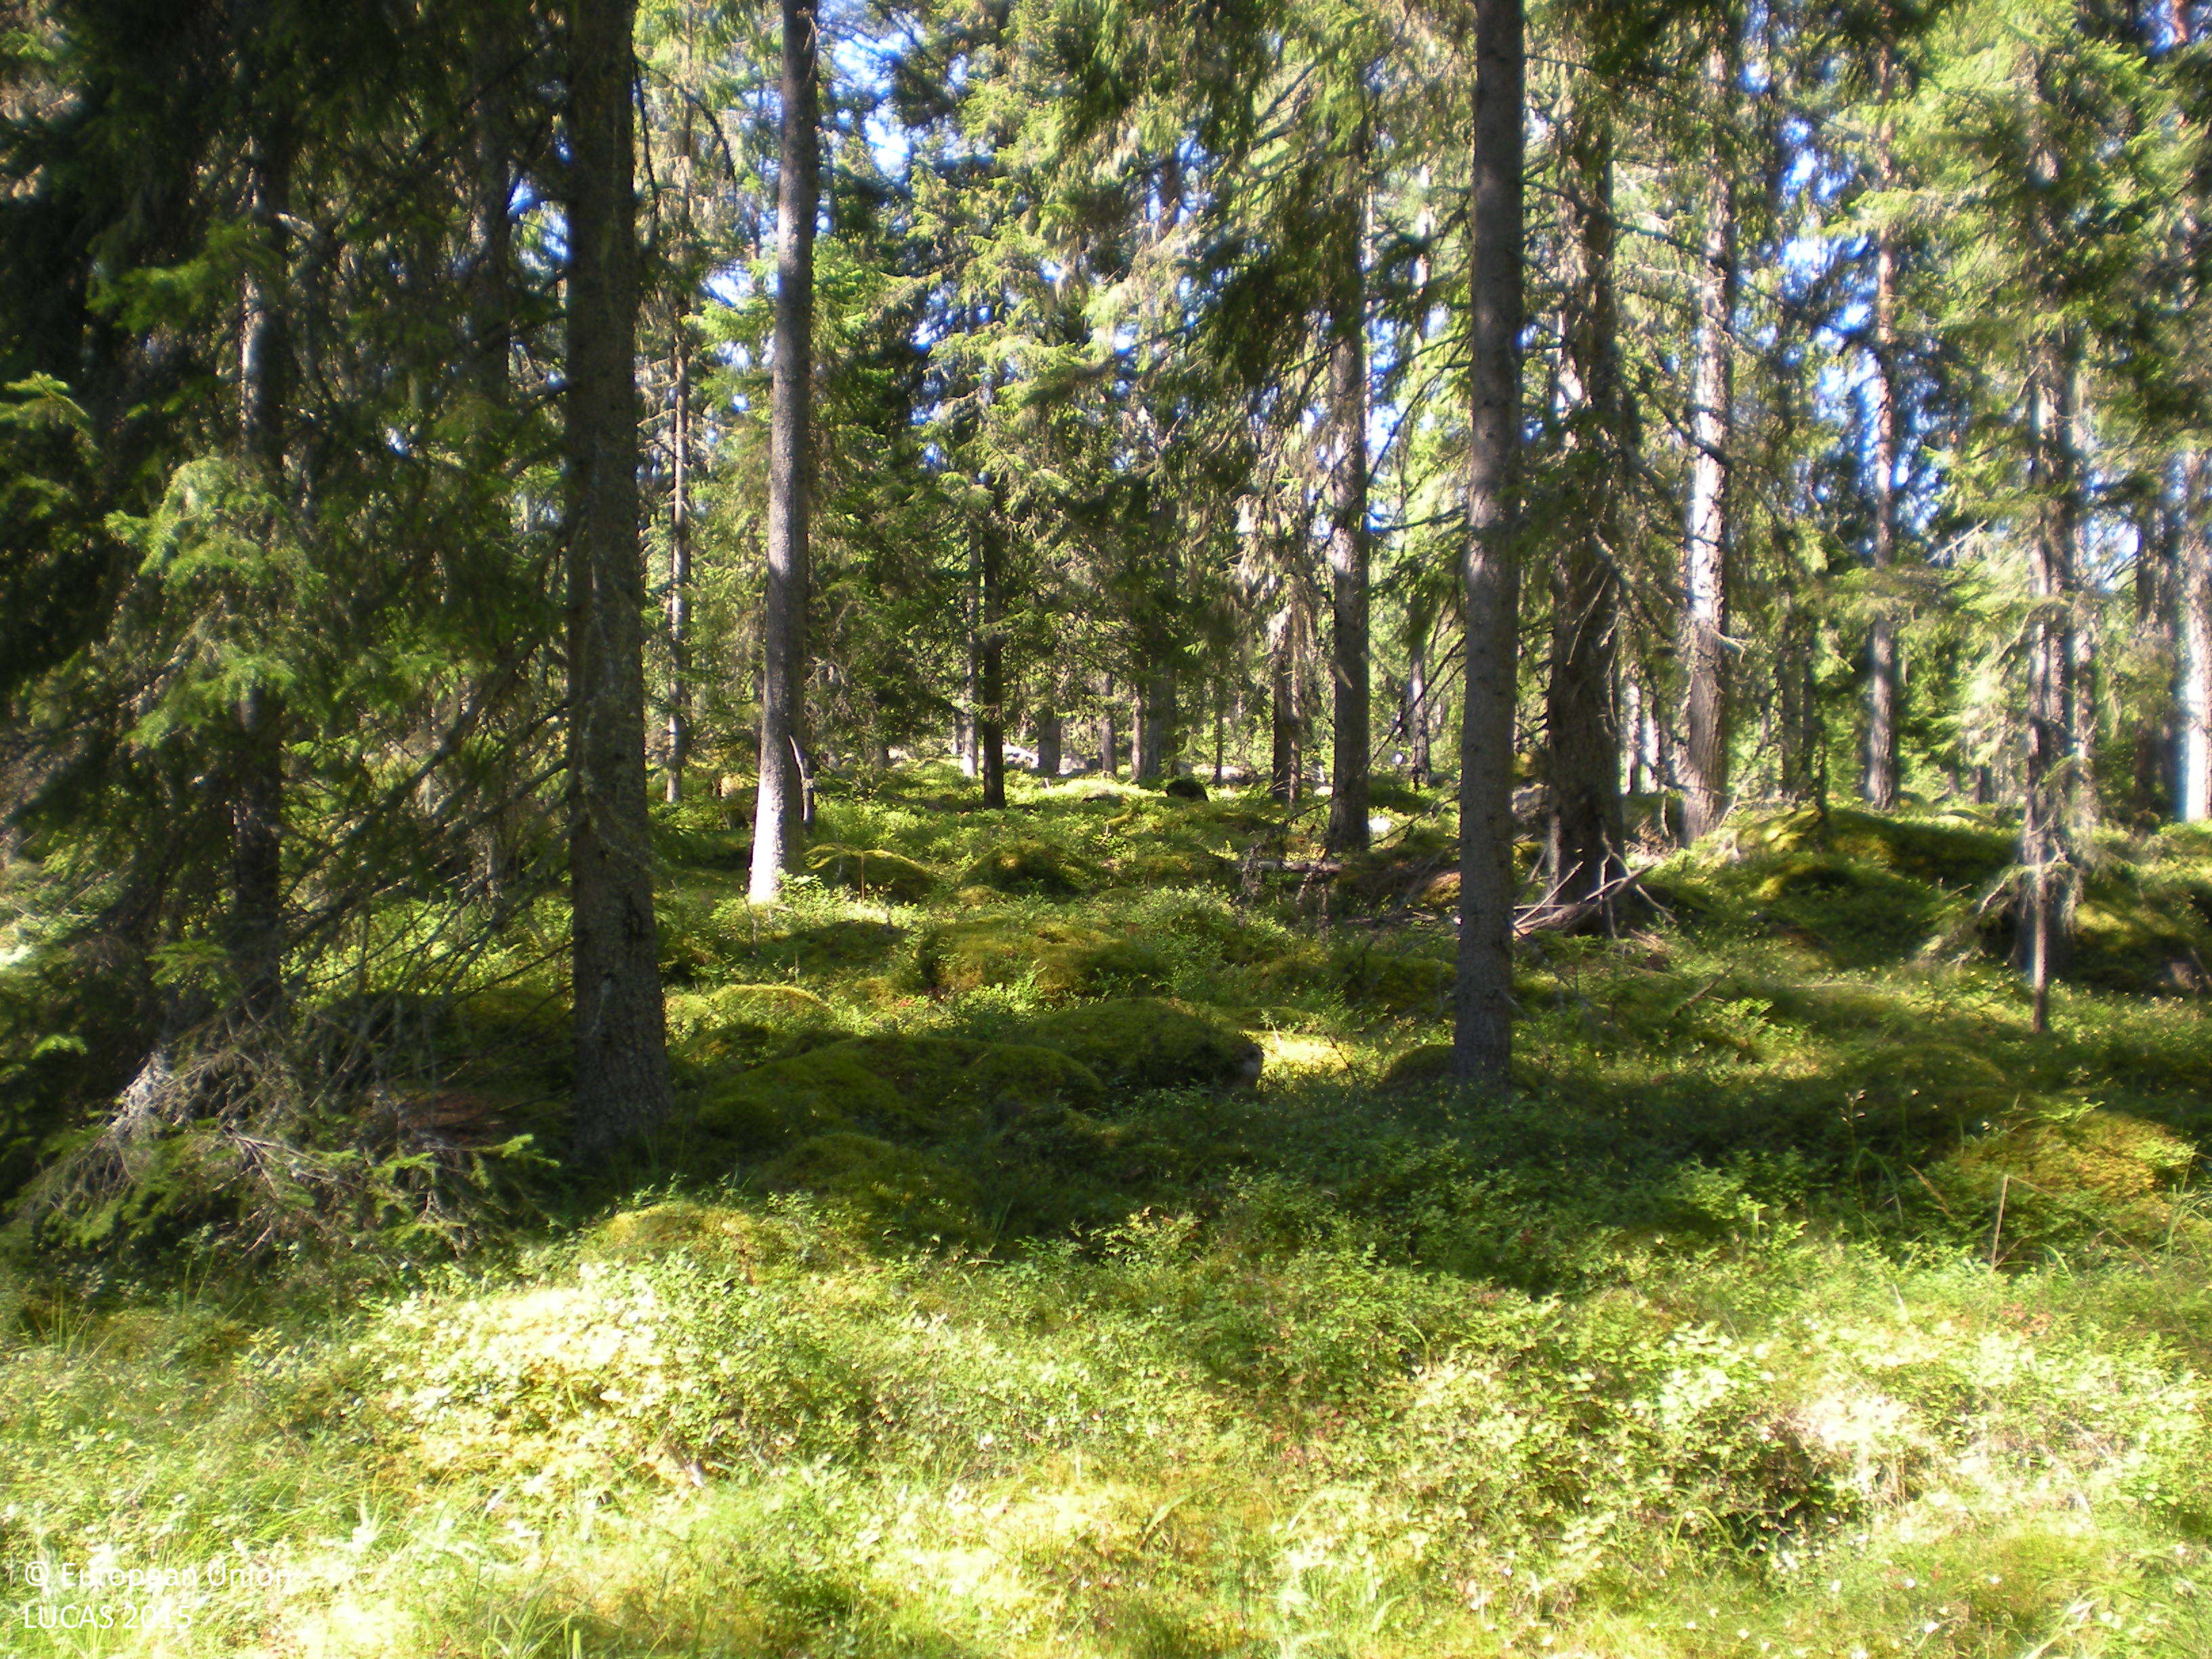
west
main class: Woodland
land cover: Spruce dominated coniferous woodland
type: boreal forest
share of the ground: 50 - 75 %
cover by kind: coniferous forest trees 65 %, shrubs 20 %, herbaceous plants 10 %, lichens and mosses 5 %
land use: Forestry
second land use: Amenities, museums, leisure
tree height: > 5 m
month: August
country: SE
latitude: 60.7064
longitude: 17.1161
